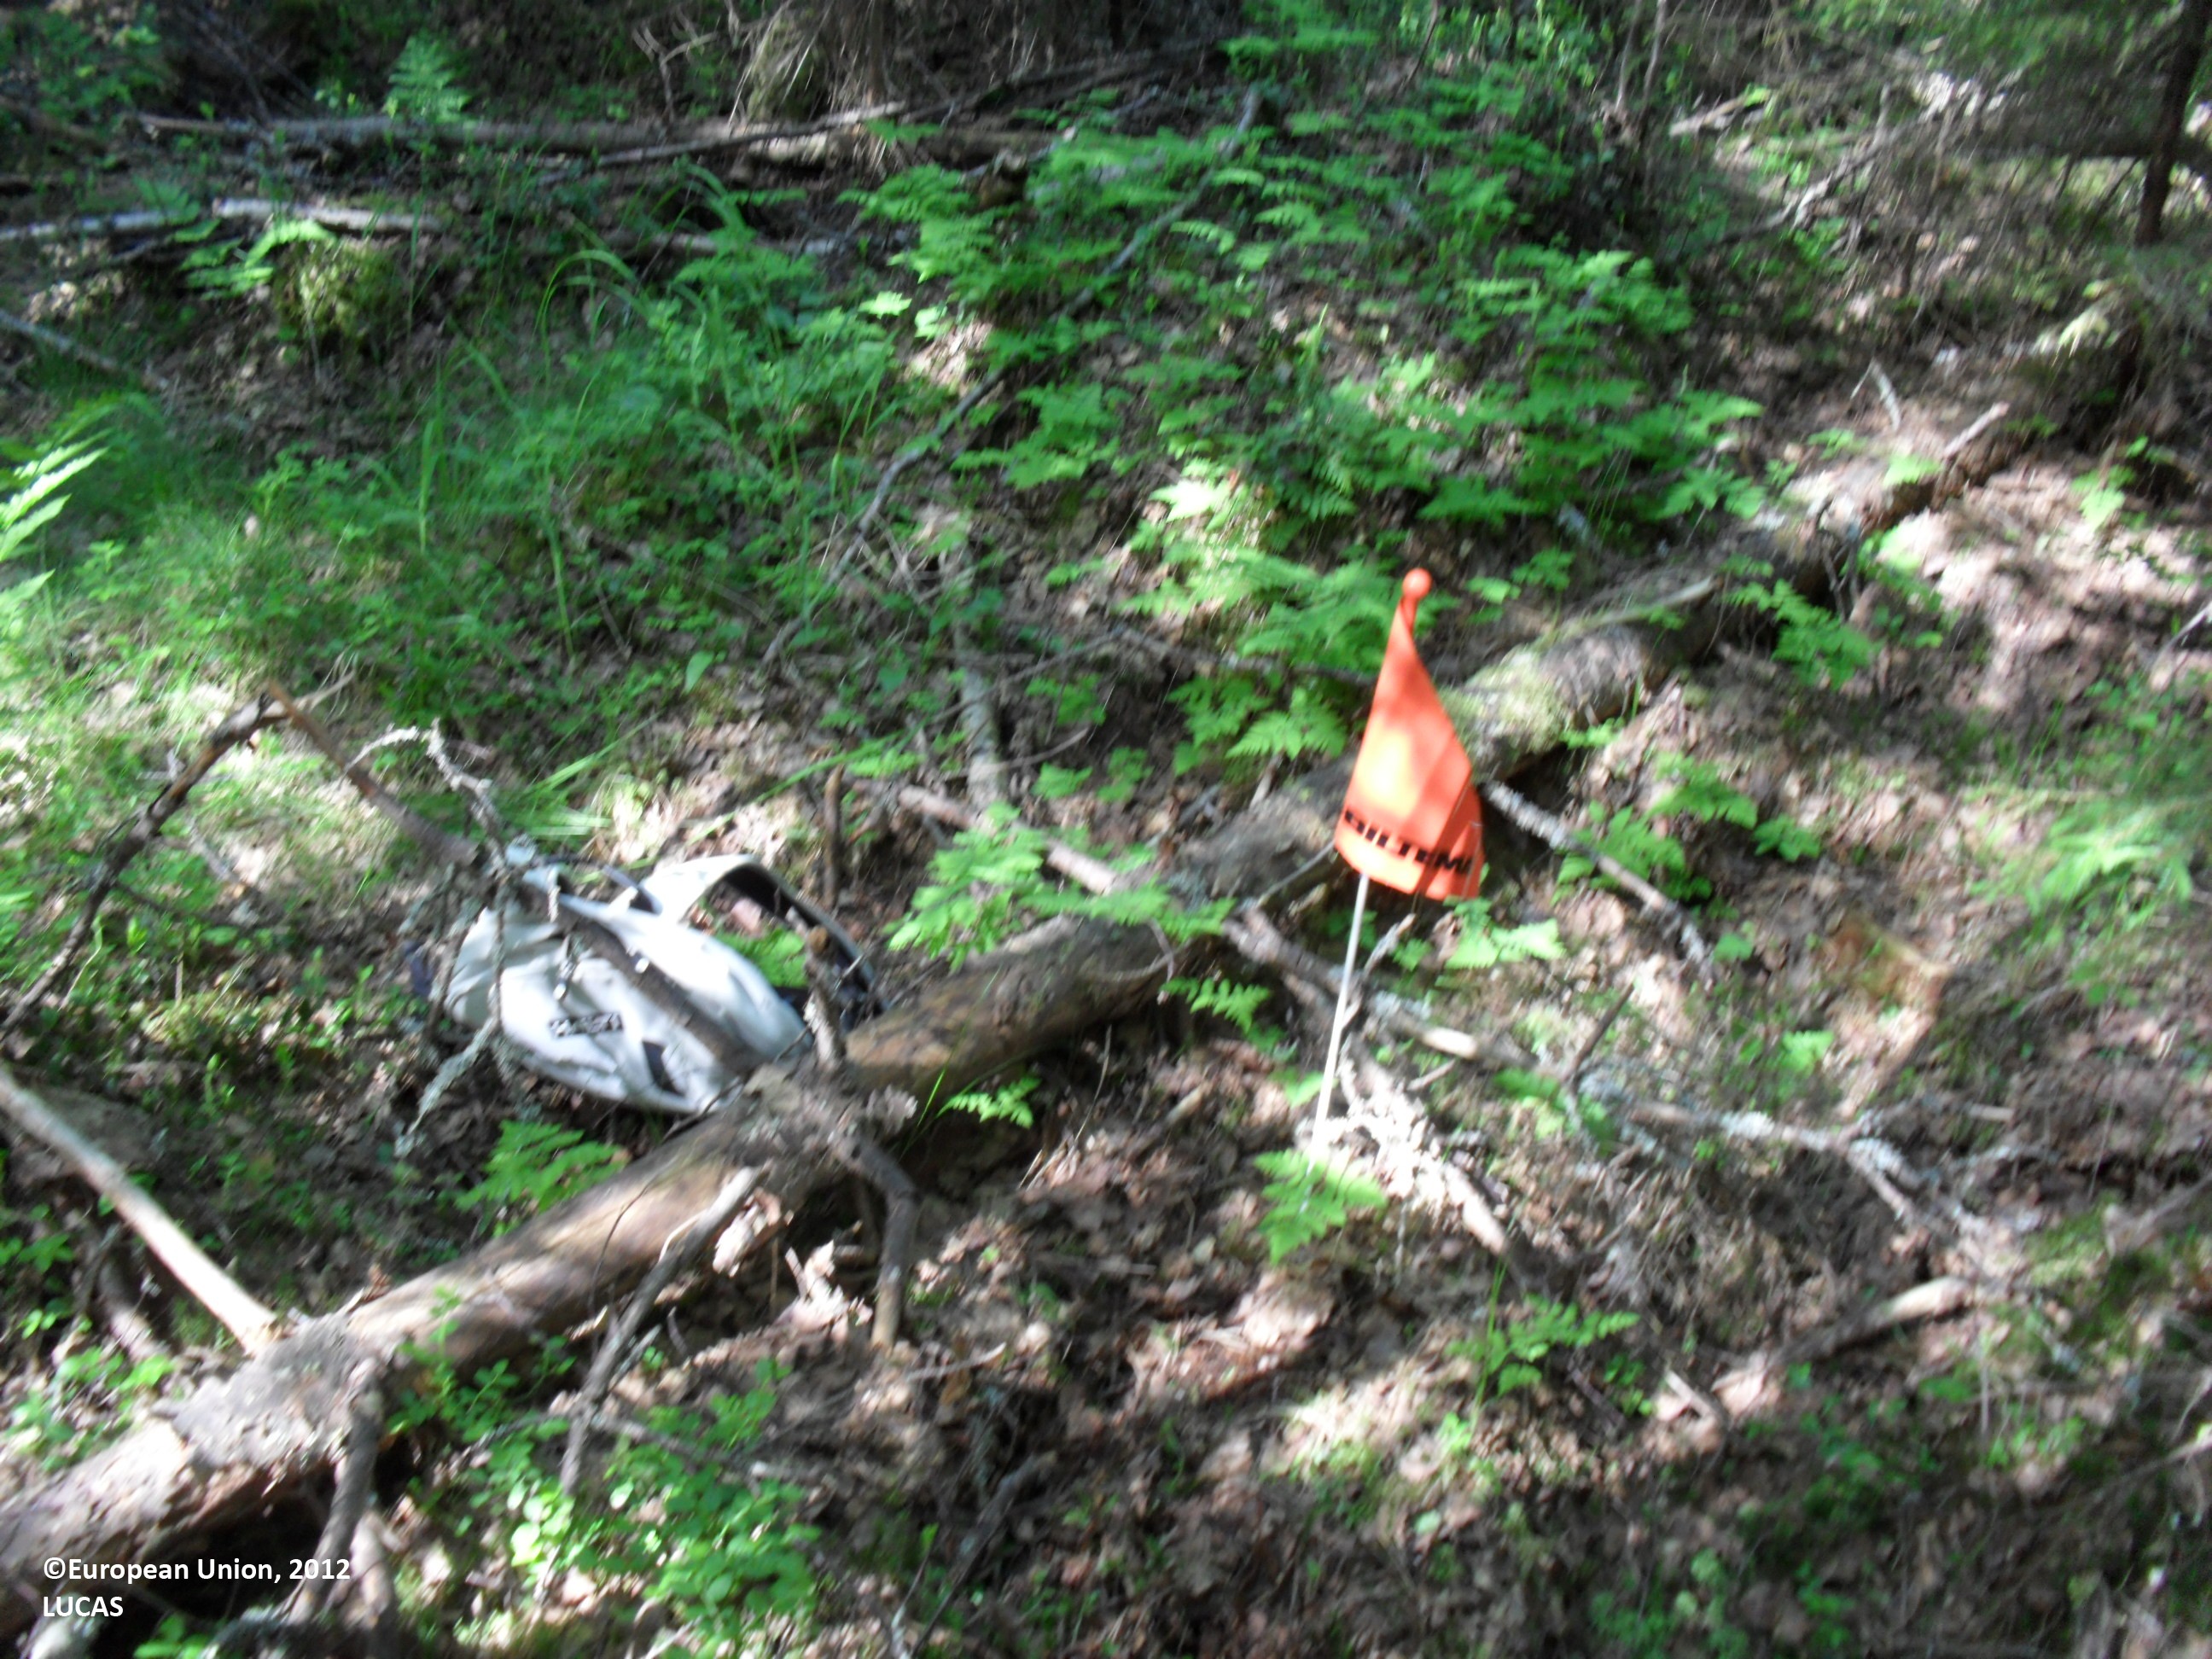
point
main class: Woodland
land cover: Other mixed woodland
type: boreal forest
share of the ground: > 75 %
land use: Forestry
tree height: > 5 m
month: June
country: FI
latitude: 62.7263
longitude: 23.3882
